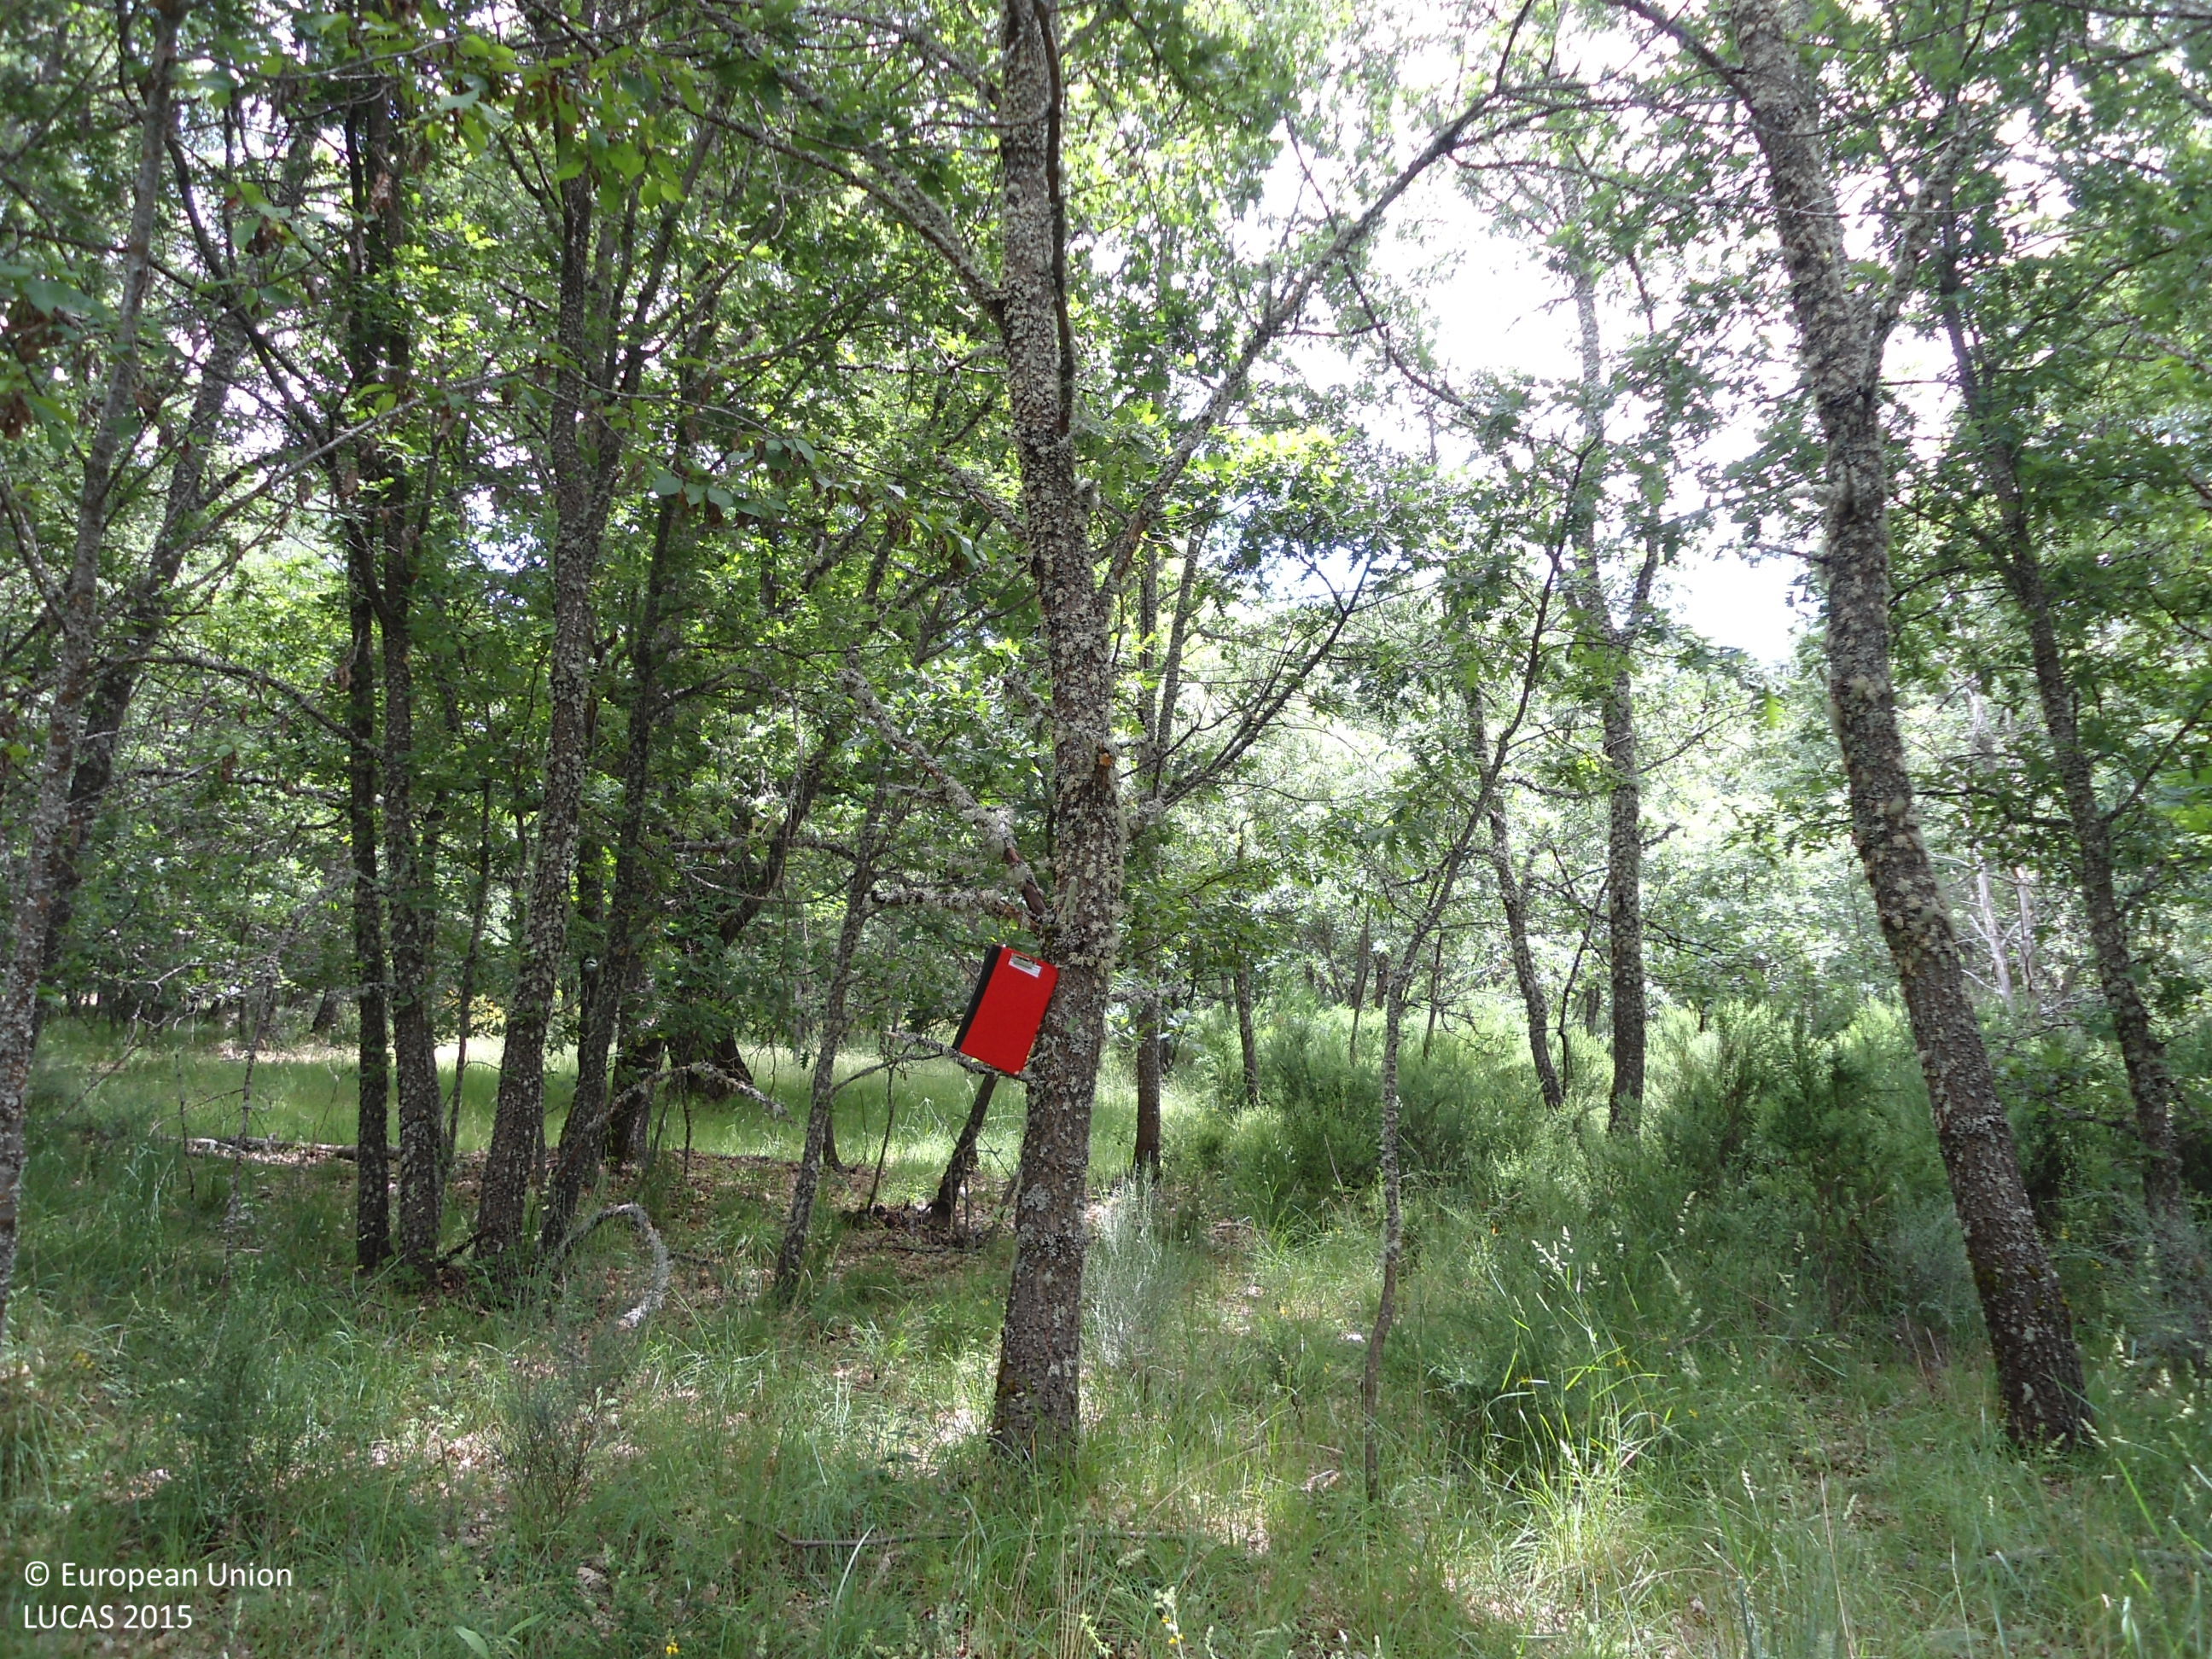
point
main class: Woodland
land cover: Broadleaved woodland
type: thermophilous deciduous forest
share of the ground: > 75 %
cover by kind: broadleaved forest trees 100 %
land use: Forestry
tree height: > 5 m
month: June
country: ES
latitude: 42.0842
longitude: -6.5901
